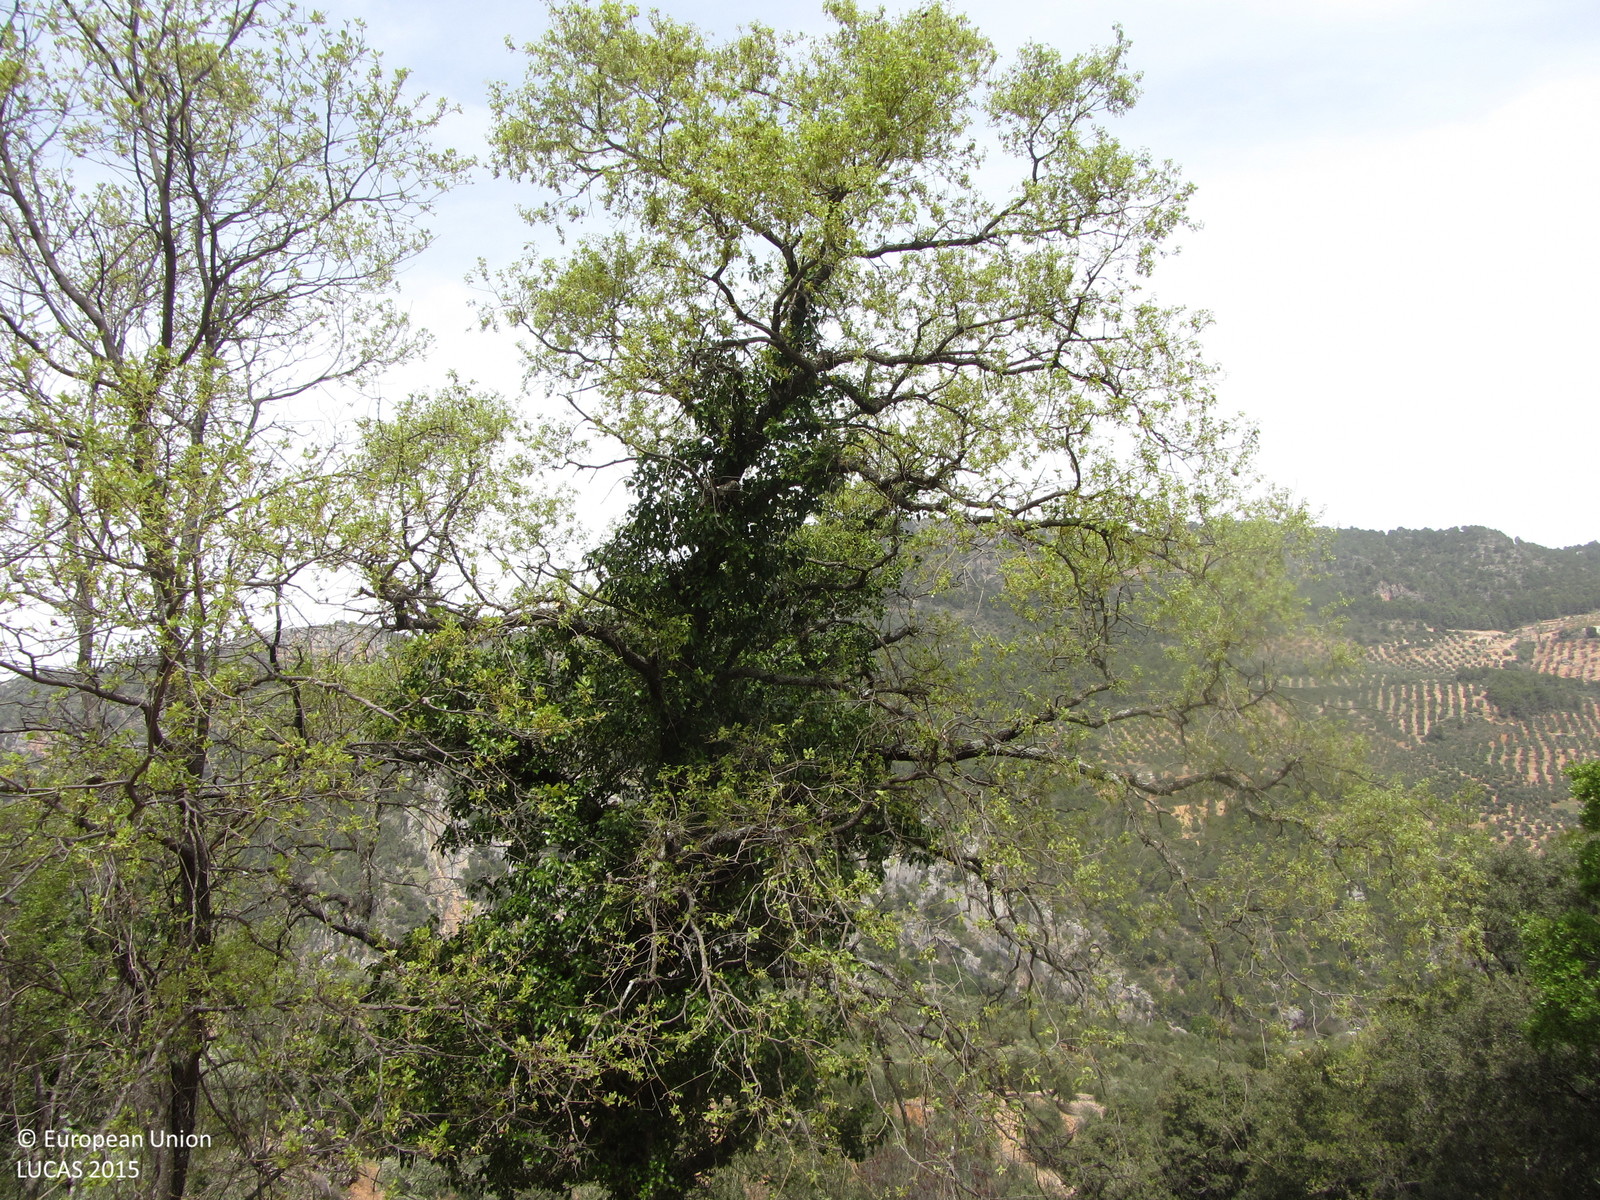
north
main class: Cropland
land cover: Olive groves
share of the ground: 25 - 50 %
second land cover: Other bare soil
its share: > 75 %
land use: Agriculture (excluding fallow land and kitchen gardens)
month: April
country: ES
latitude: 38.0881
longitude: -2.9380
